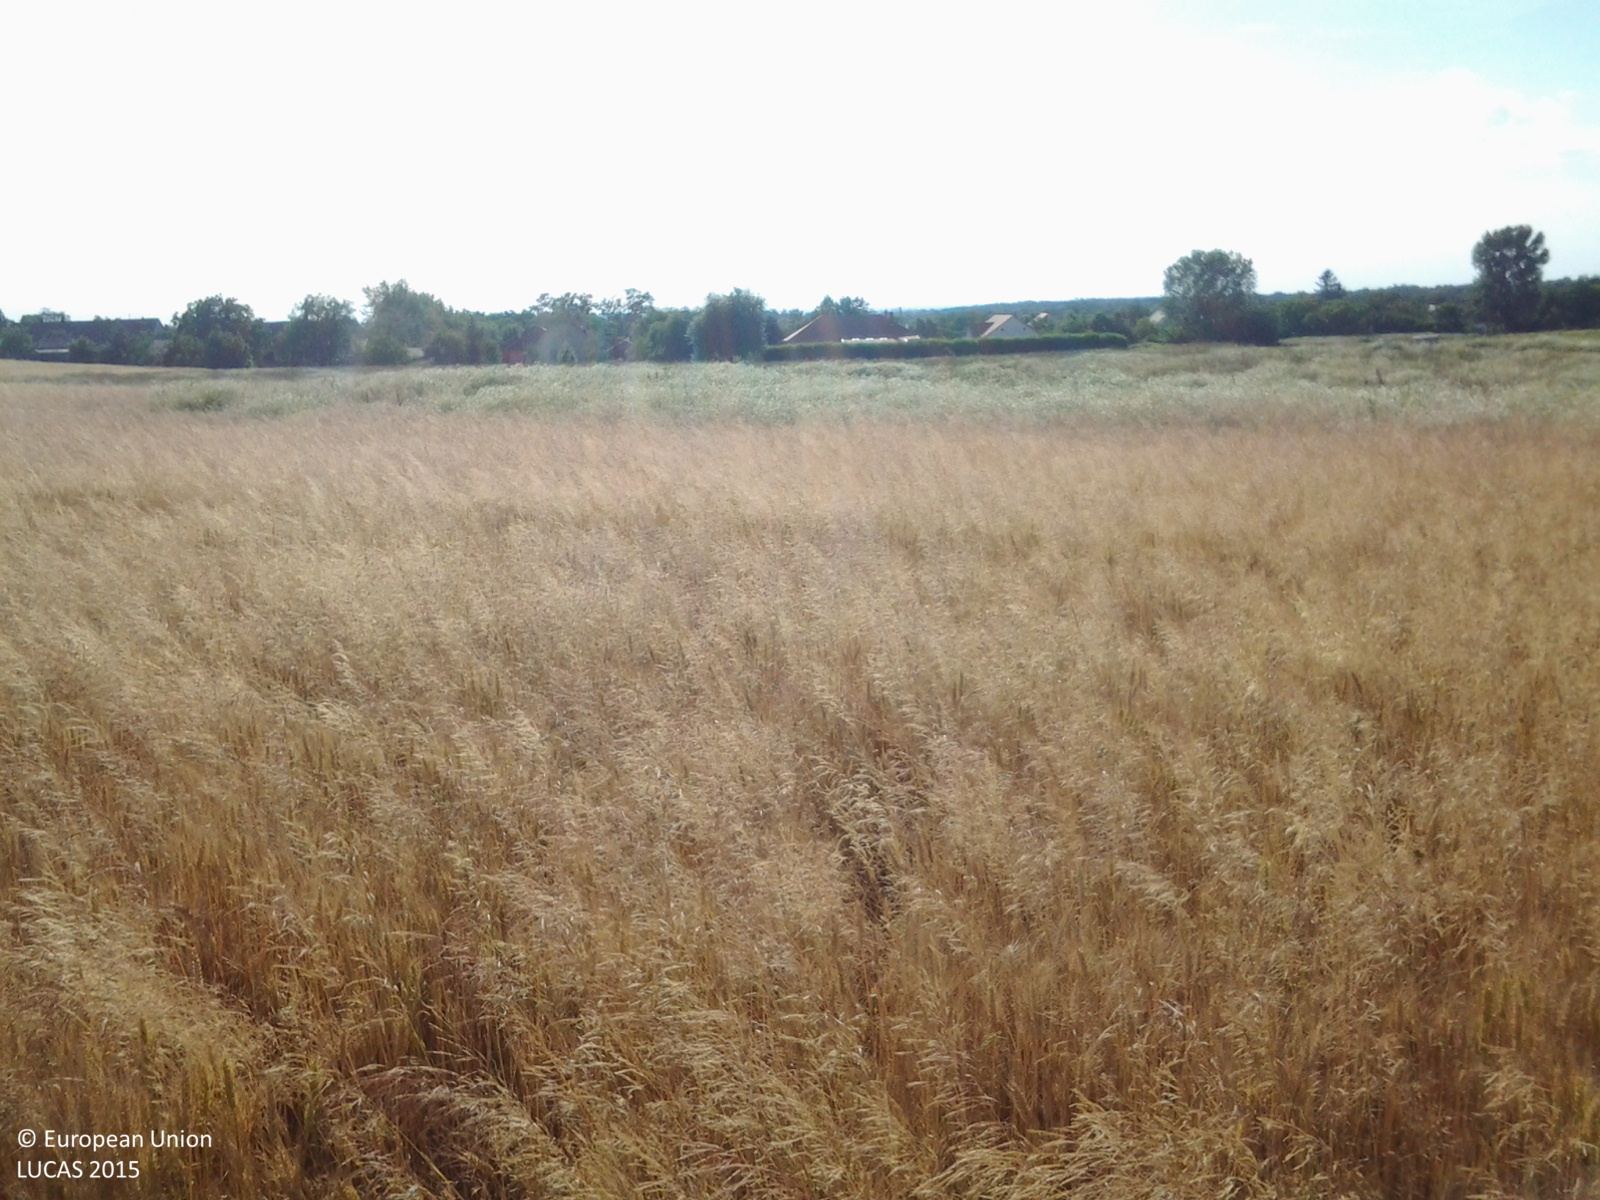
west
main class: Cropland
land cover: Common wheat
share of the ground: > 75 %
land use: Agriculture (excluding fallow land and kitchen gardens)
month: June
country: HU
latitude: 47.2092
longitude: 17.4931
